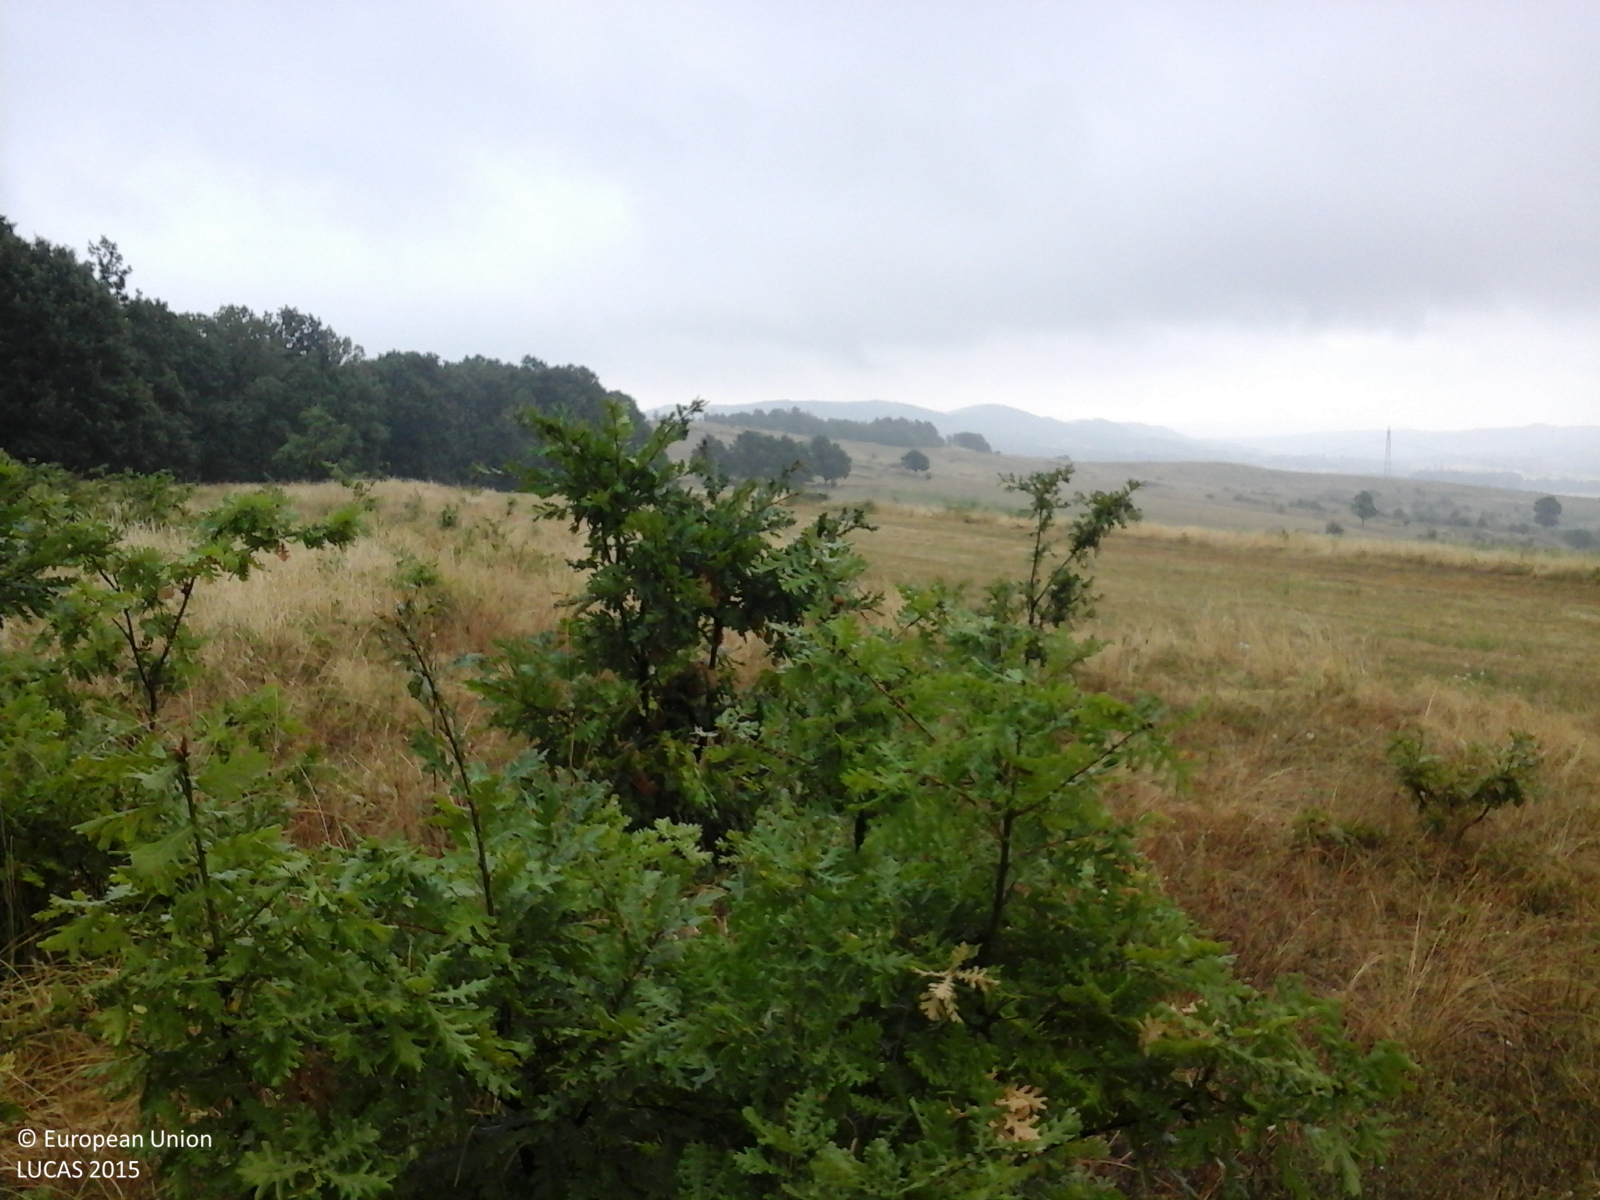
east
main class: Shrubland
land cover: Shrubland with sparse tree cover
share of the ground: > 75 %
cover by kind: shrubs 80 %, herbaceous plants 15 %, broadleaved forest trees 5 %
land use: Agriculture (excluding fallow land and kitchen gardens)
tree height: < 5 m
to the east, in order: Shrubland with sparse tree cover; Grassland without tree/shrub cover
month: August
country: RO
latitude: 44.7653
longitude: 22.7413
